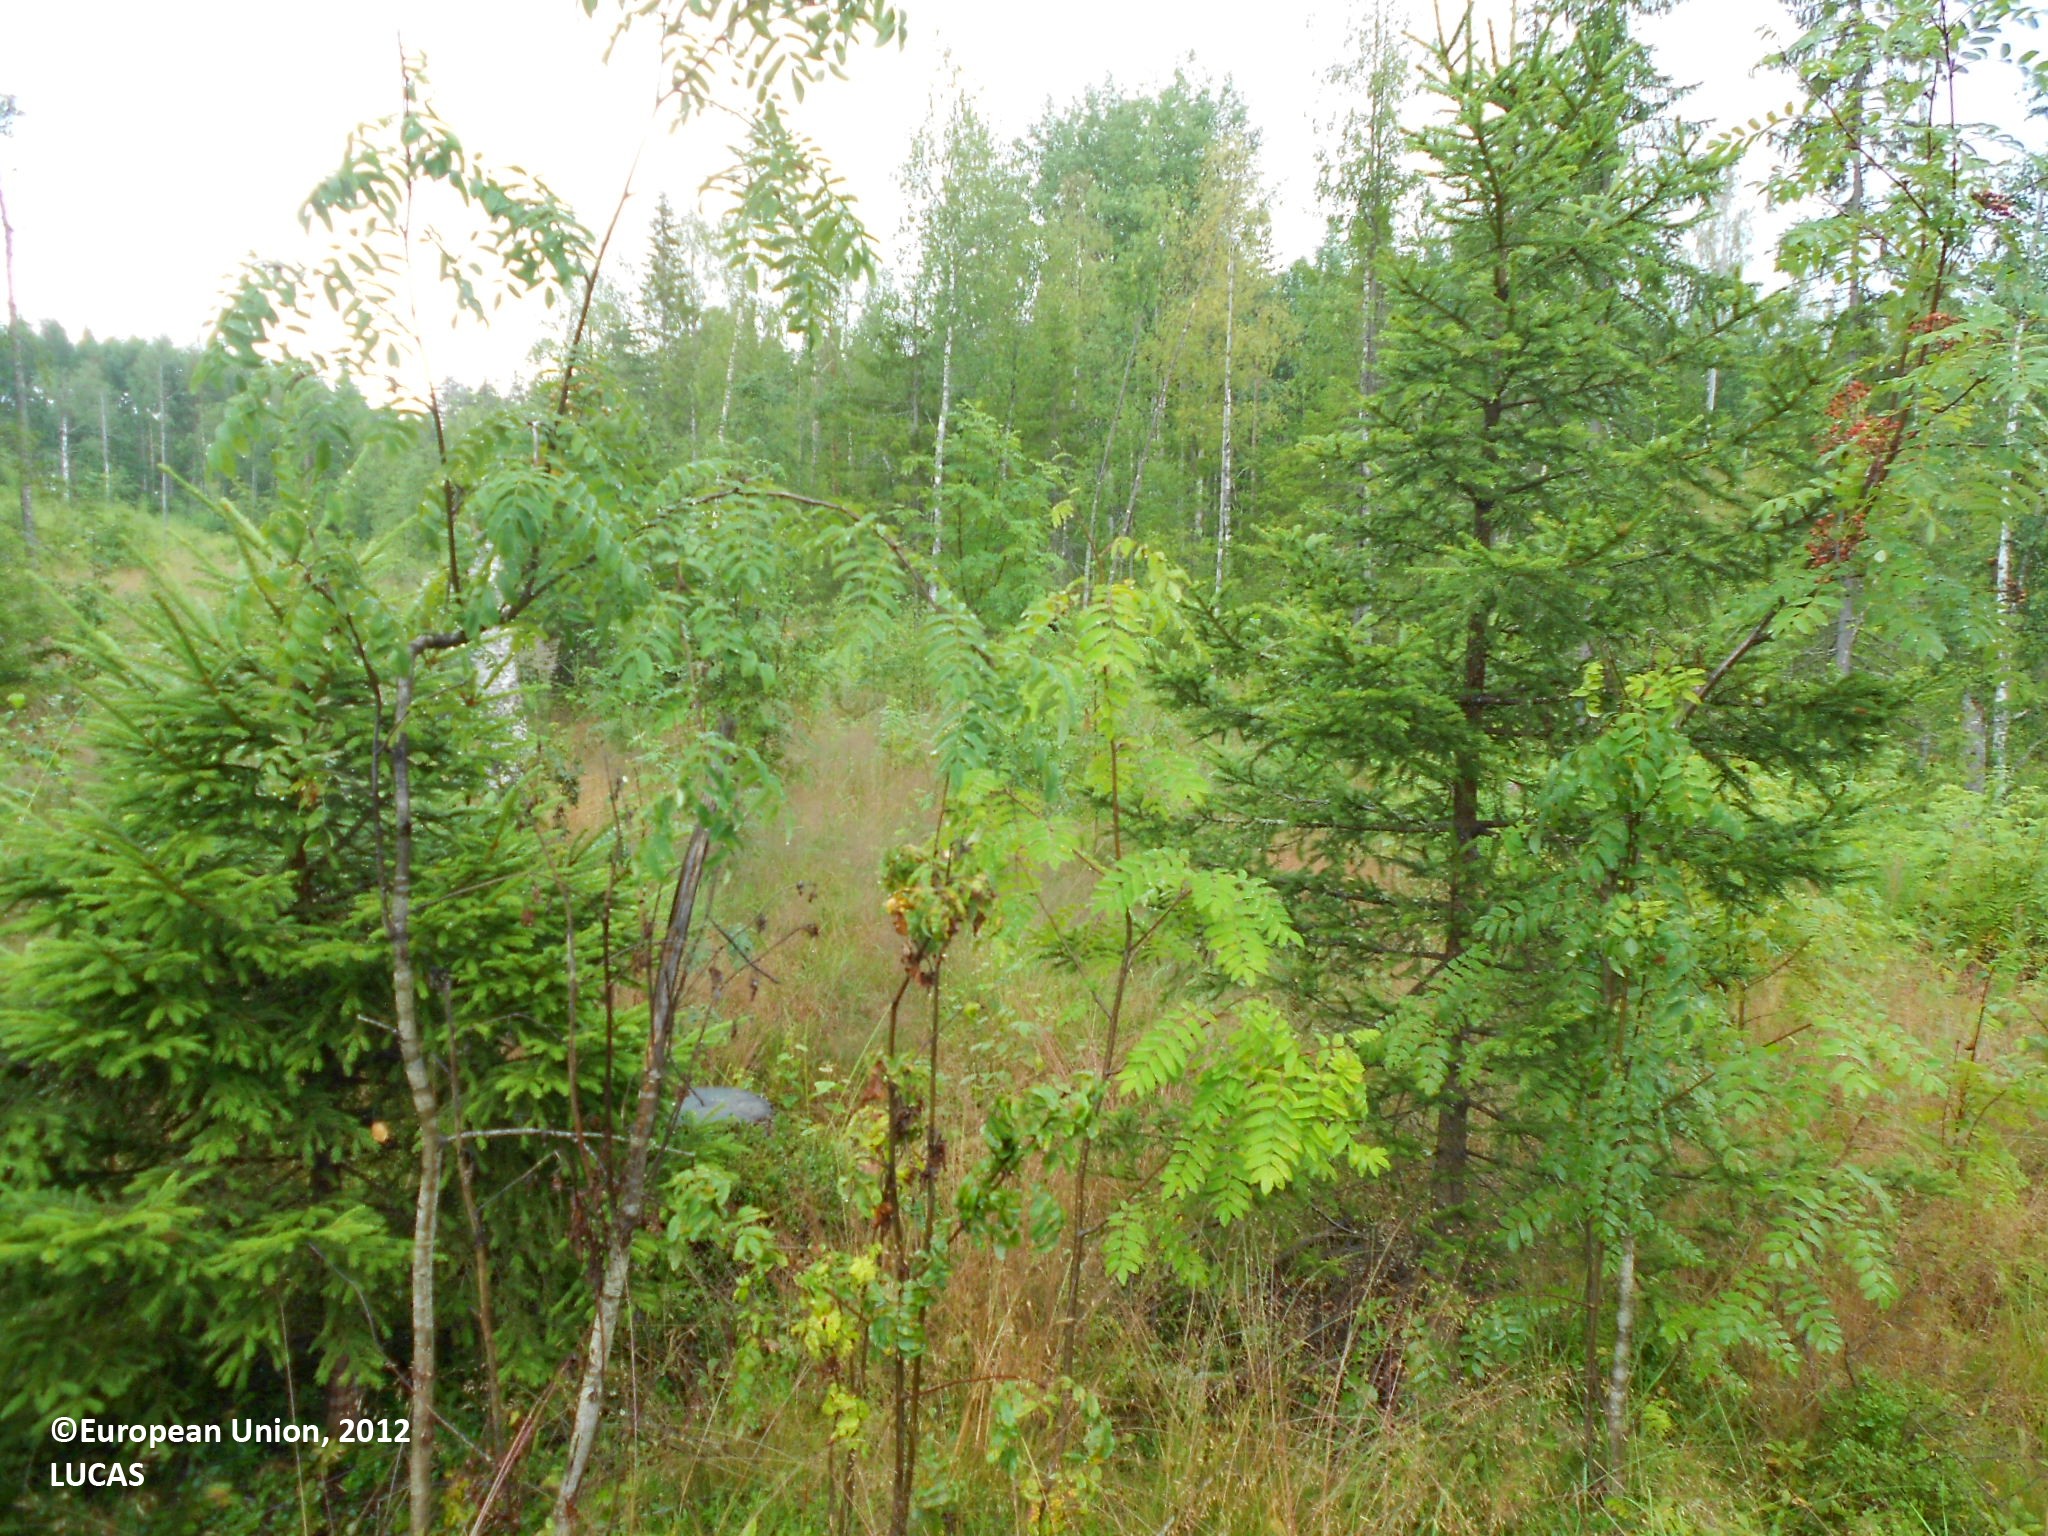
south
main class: Shrubland
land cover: Shrubland with sparse tree cover
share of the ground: > 75 %
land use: Forestry
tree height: < 5 m
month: August
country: FI
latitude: 63.4582
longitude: 28.3786
